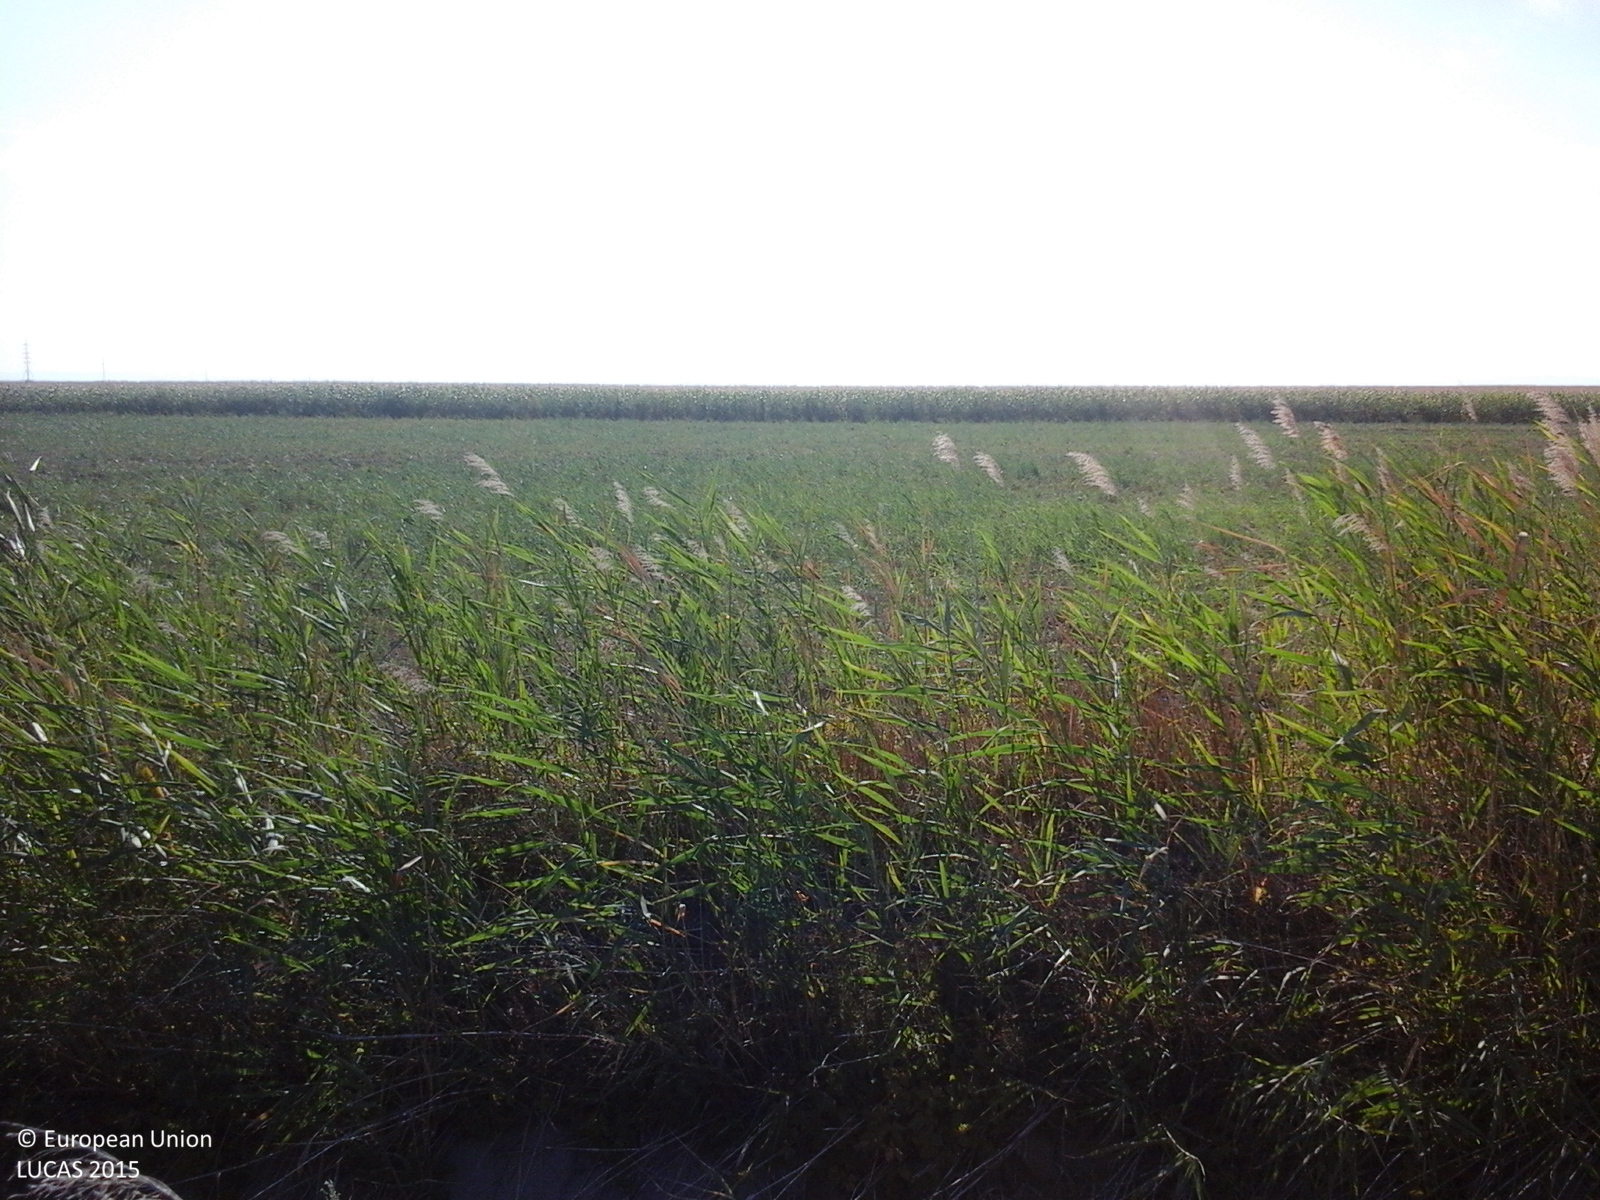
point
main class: Cropland
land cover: Temporary grasslands
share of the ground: > 75 %
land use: Agriculture (excluding fallow land and kitchen gardens)
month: August
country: RO
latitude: 45.5849
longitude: 27.4427
